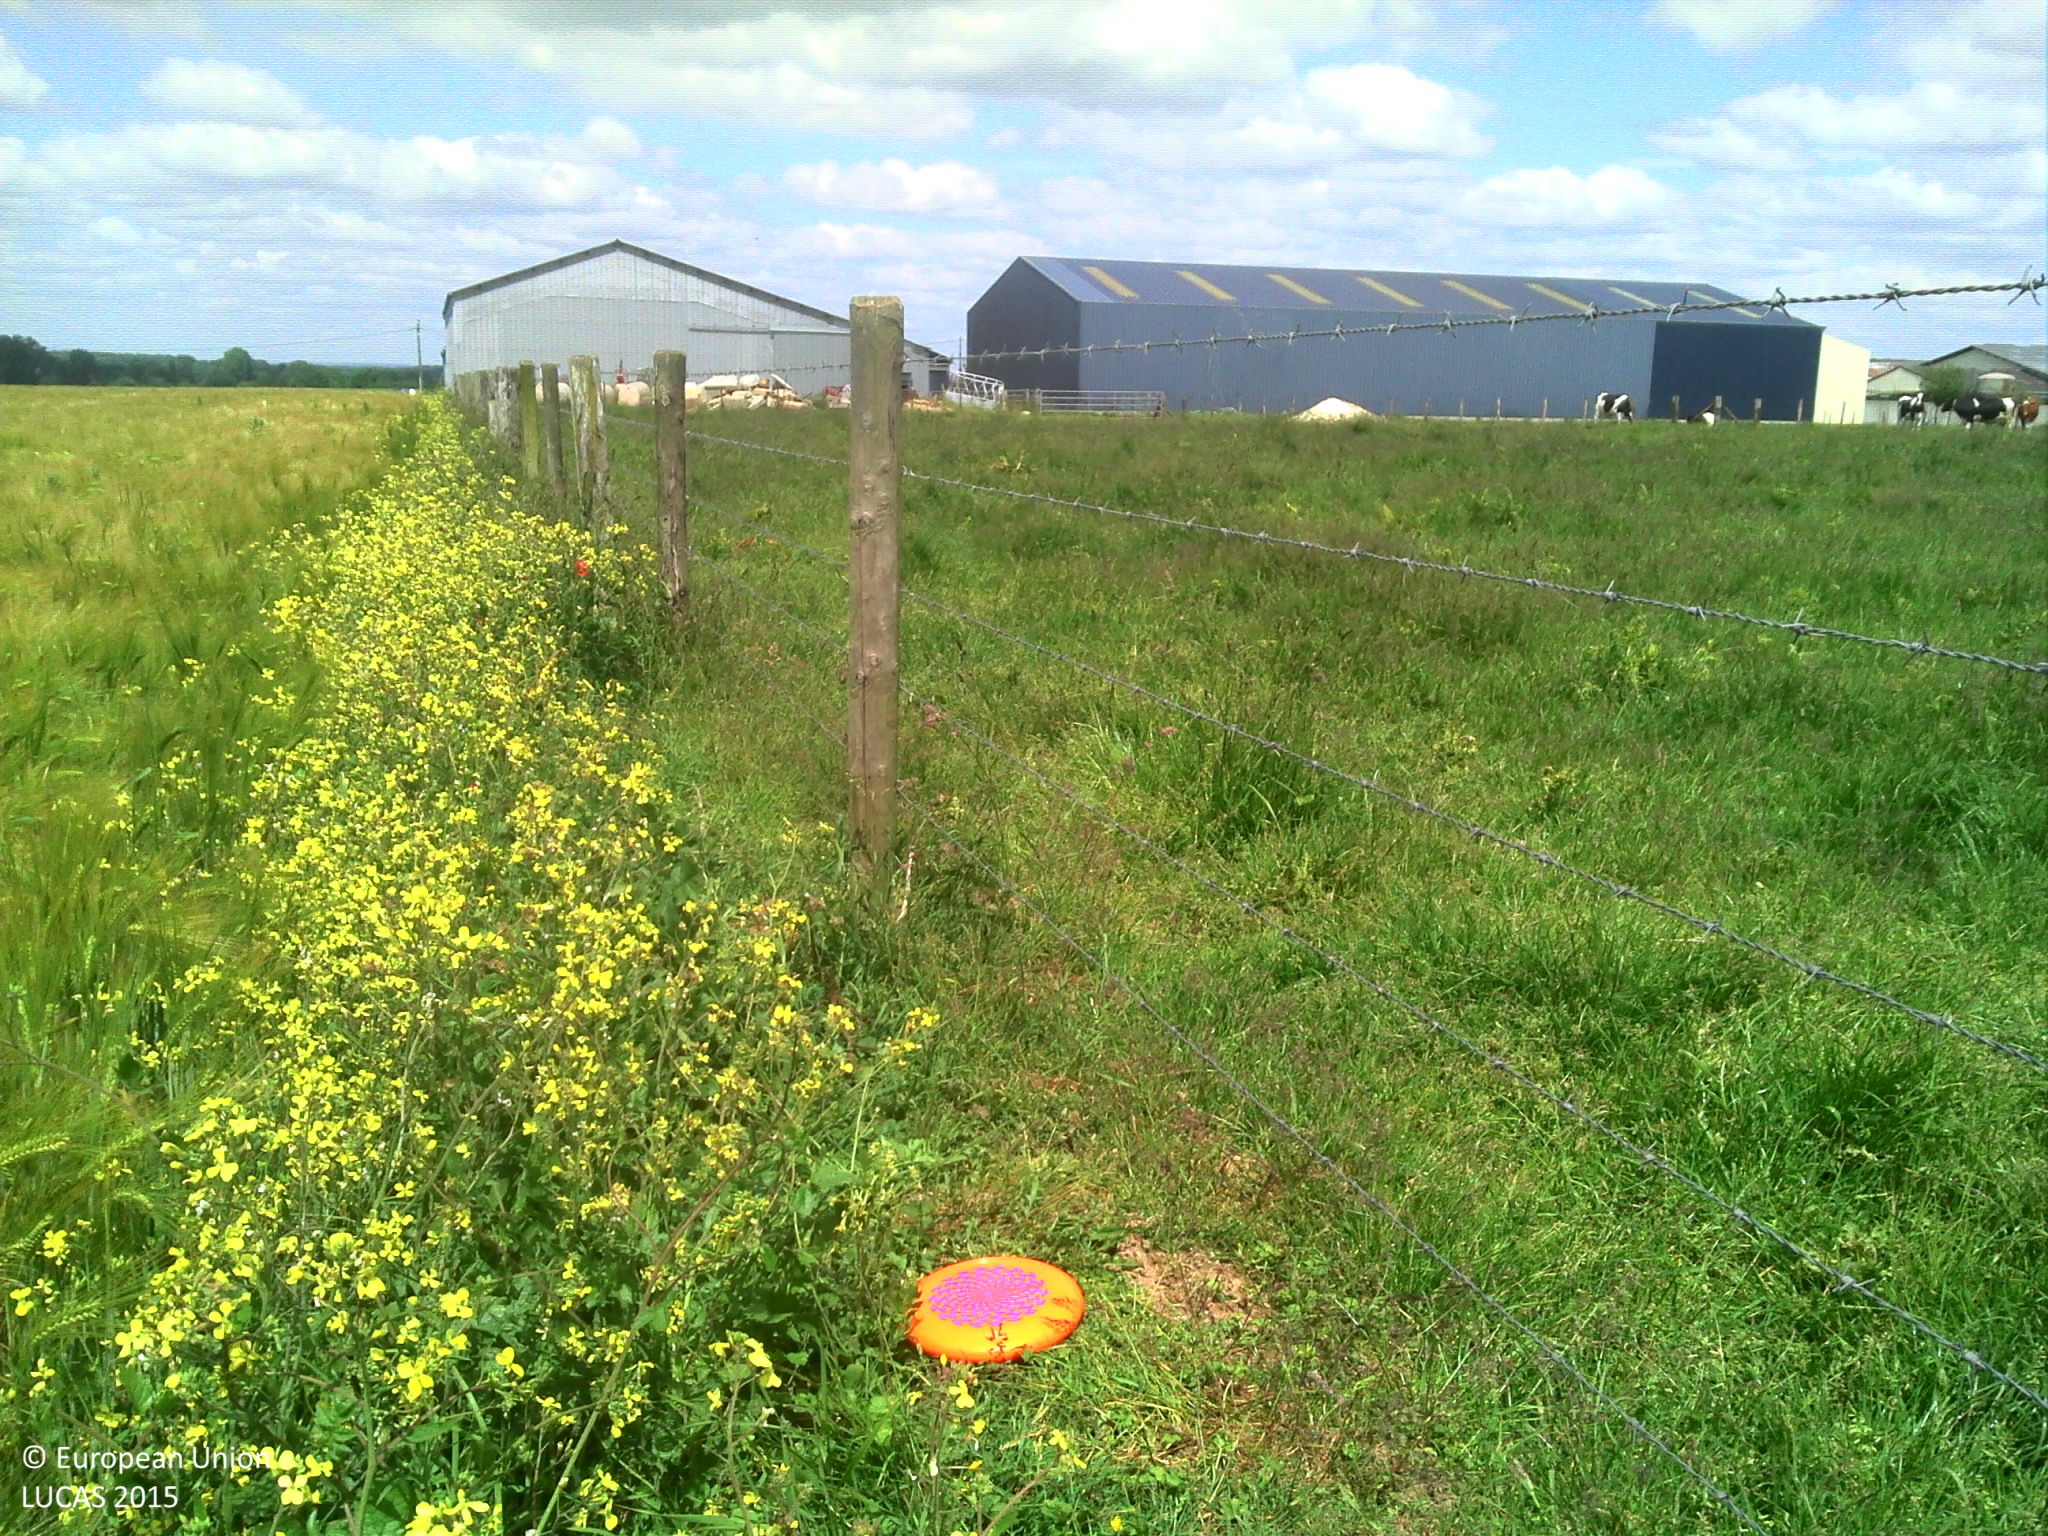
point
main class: Cropland
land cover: Barley
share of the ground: > 75 %
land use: Agriculture (excluding fallow land and kitchen gardens)
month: June
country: FR
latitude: 50.1135
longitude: 1.6616
